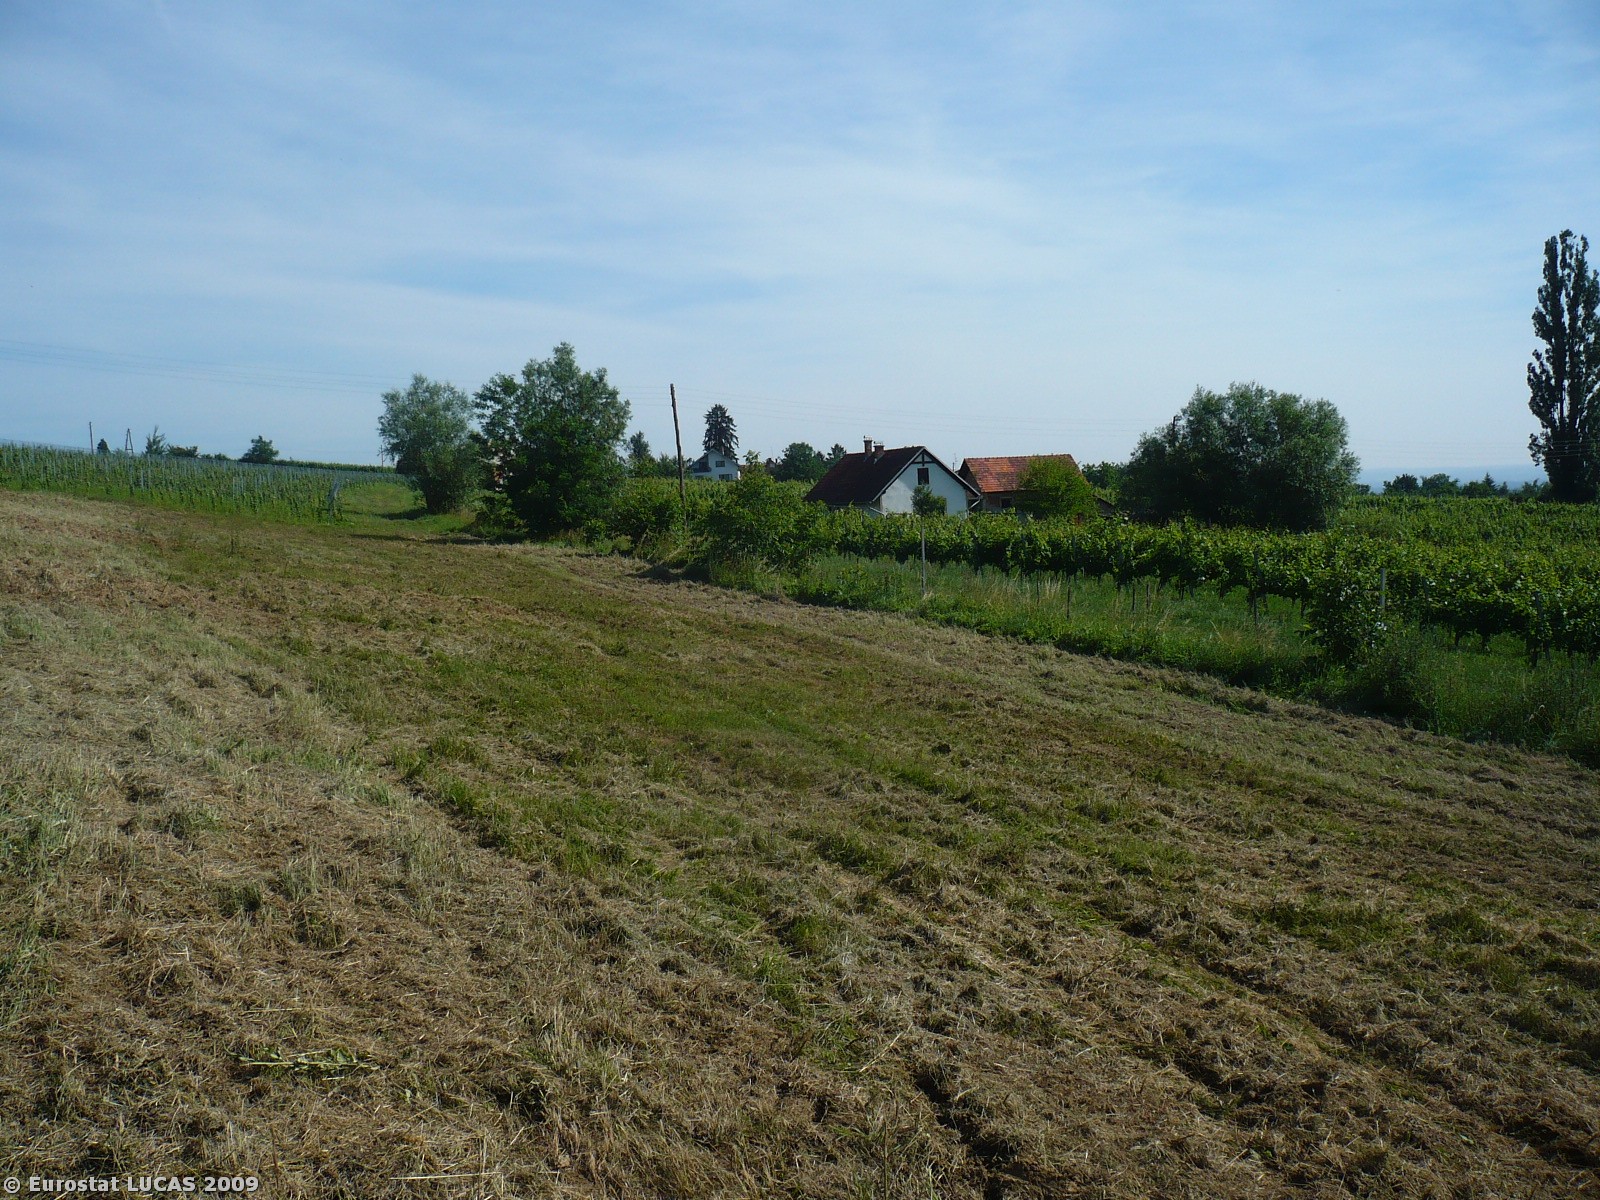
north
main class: Grassland
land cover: Grassland without tree/shrub cover
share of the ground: > 75 %
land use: Agriculture (excluding fallow land and kitchen gardens)
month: June
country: SI
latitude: 46.6136
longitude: 16.0458
